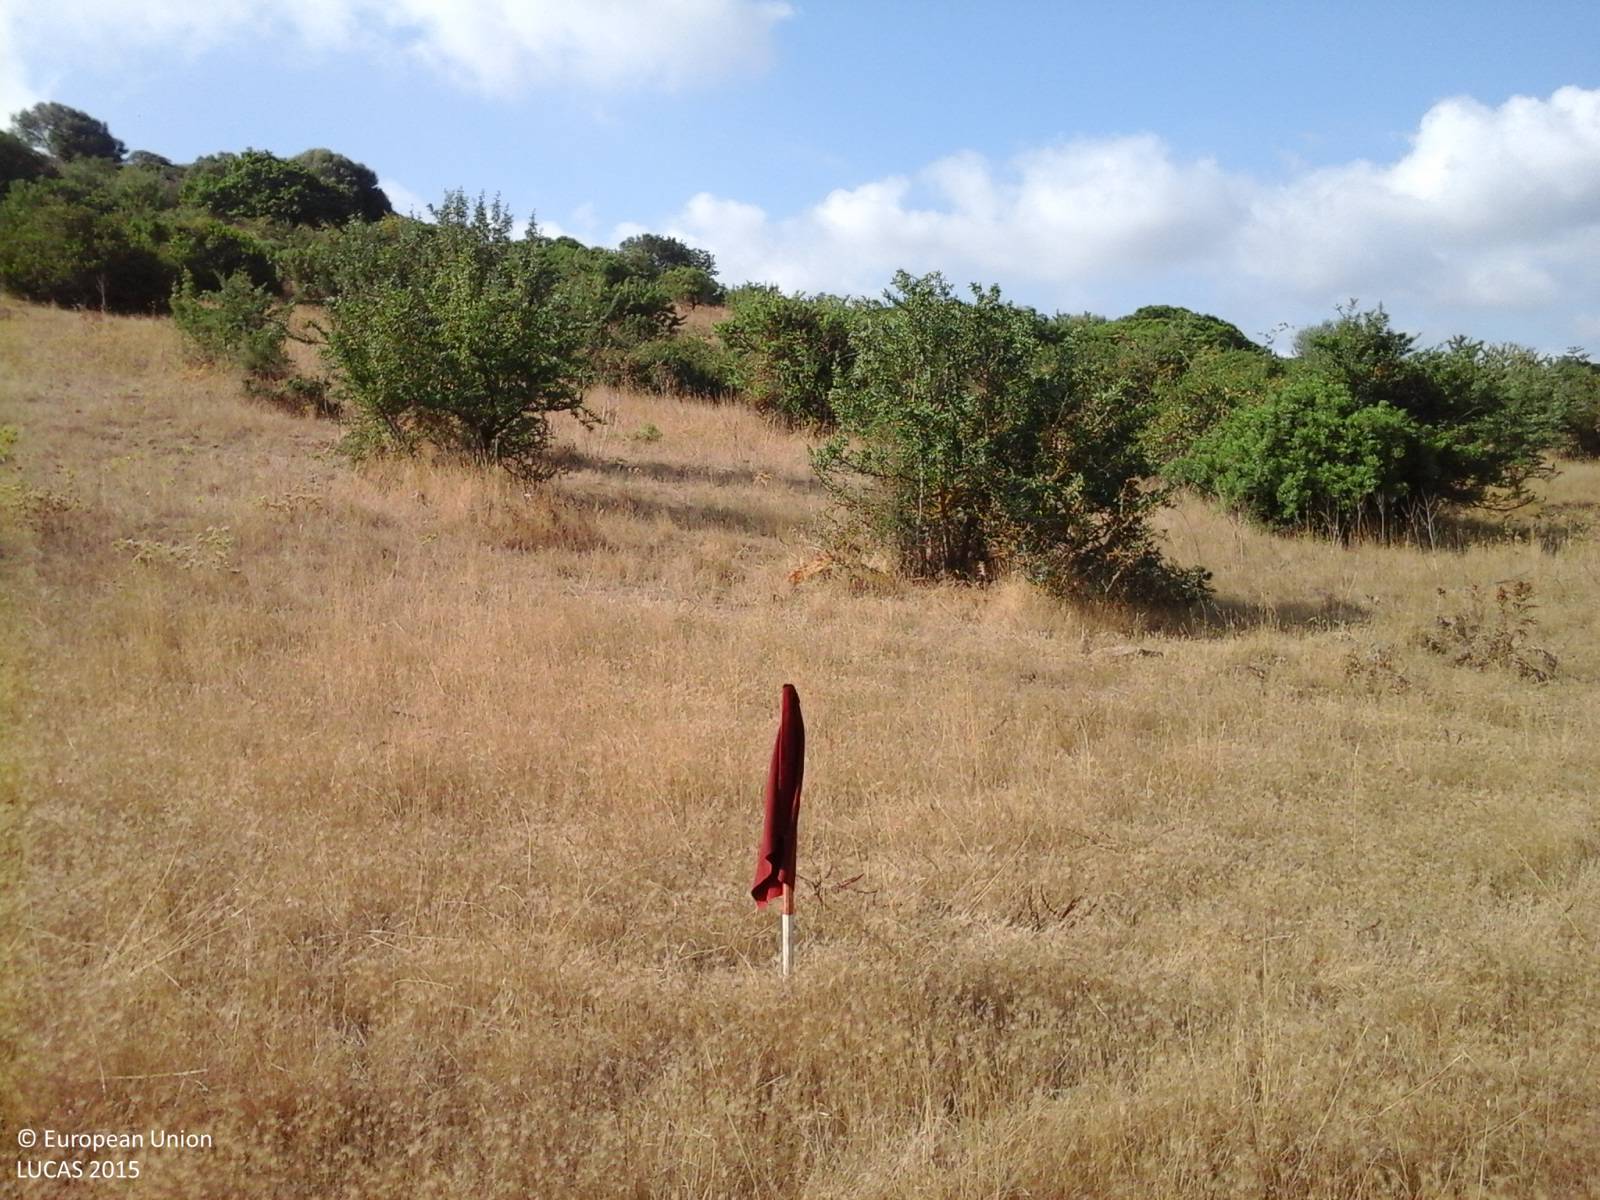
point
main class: Grassland
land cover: Grassland without tree/shrub cover
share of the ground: 50 - 75 %
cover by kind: herbaceous plants 100 %
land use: Agriculture (excluding fallow land and kitchen gardens)
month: July
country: IT
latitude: 40.6773
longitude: 8.8815
